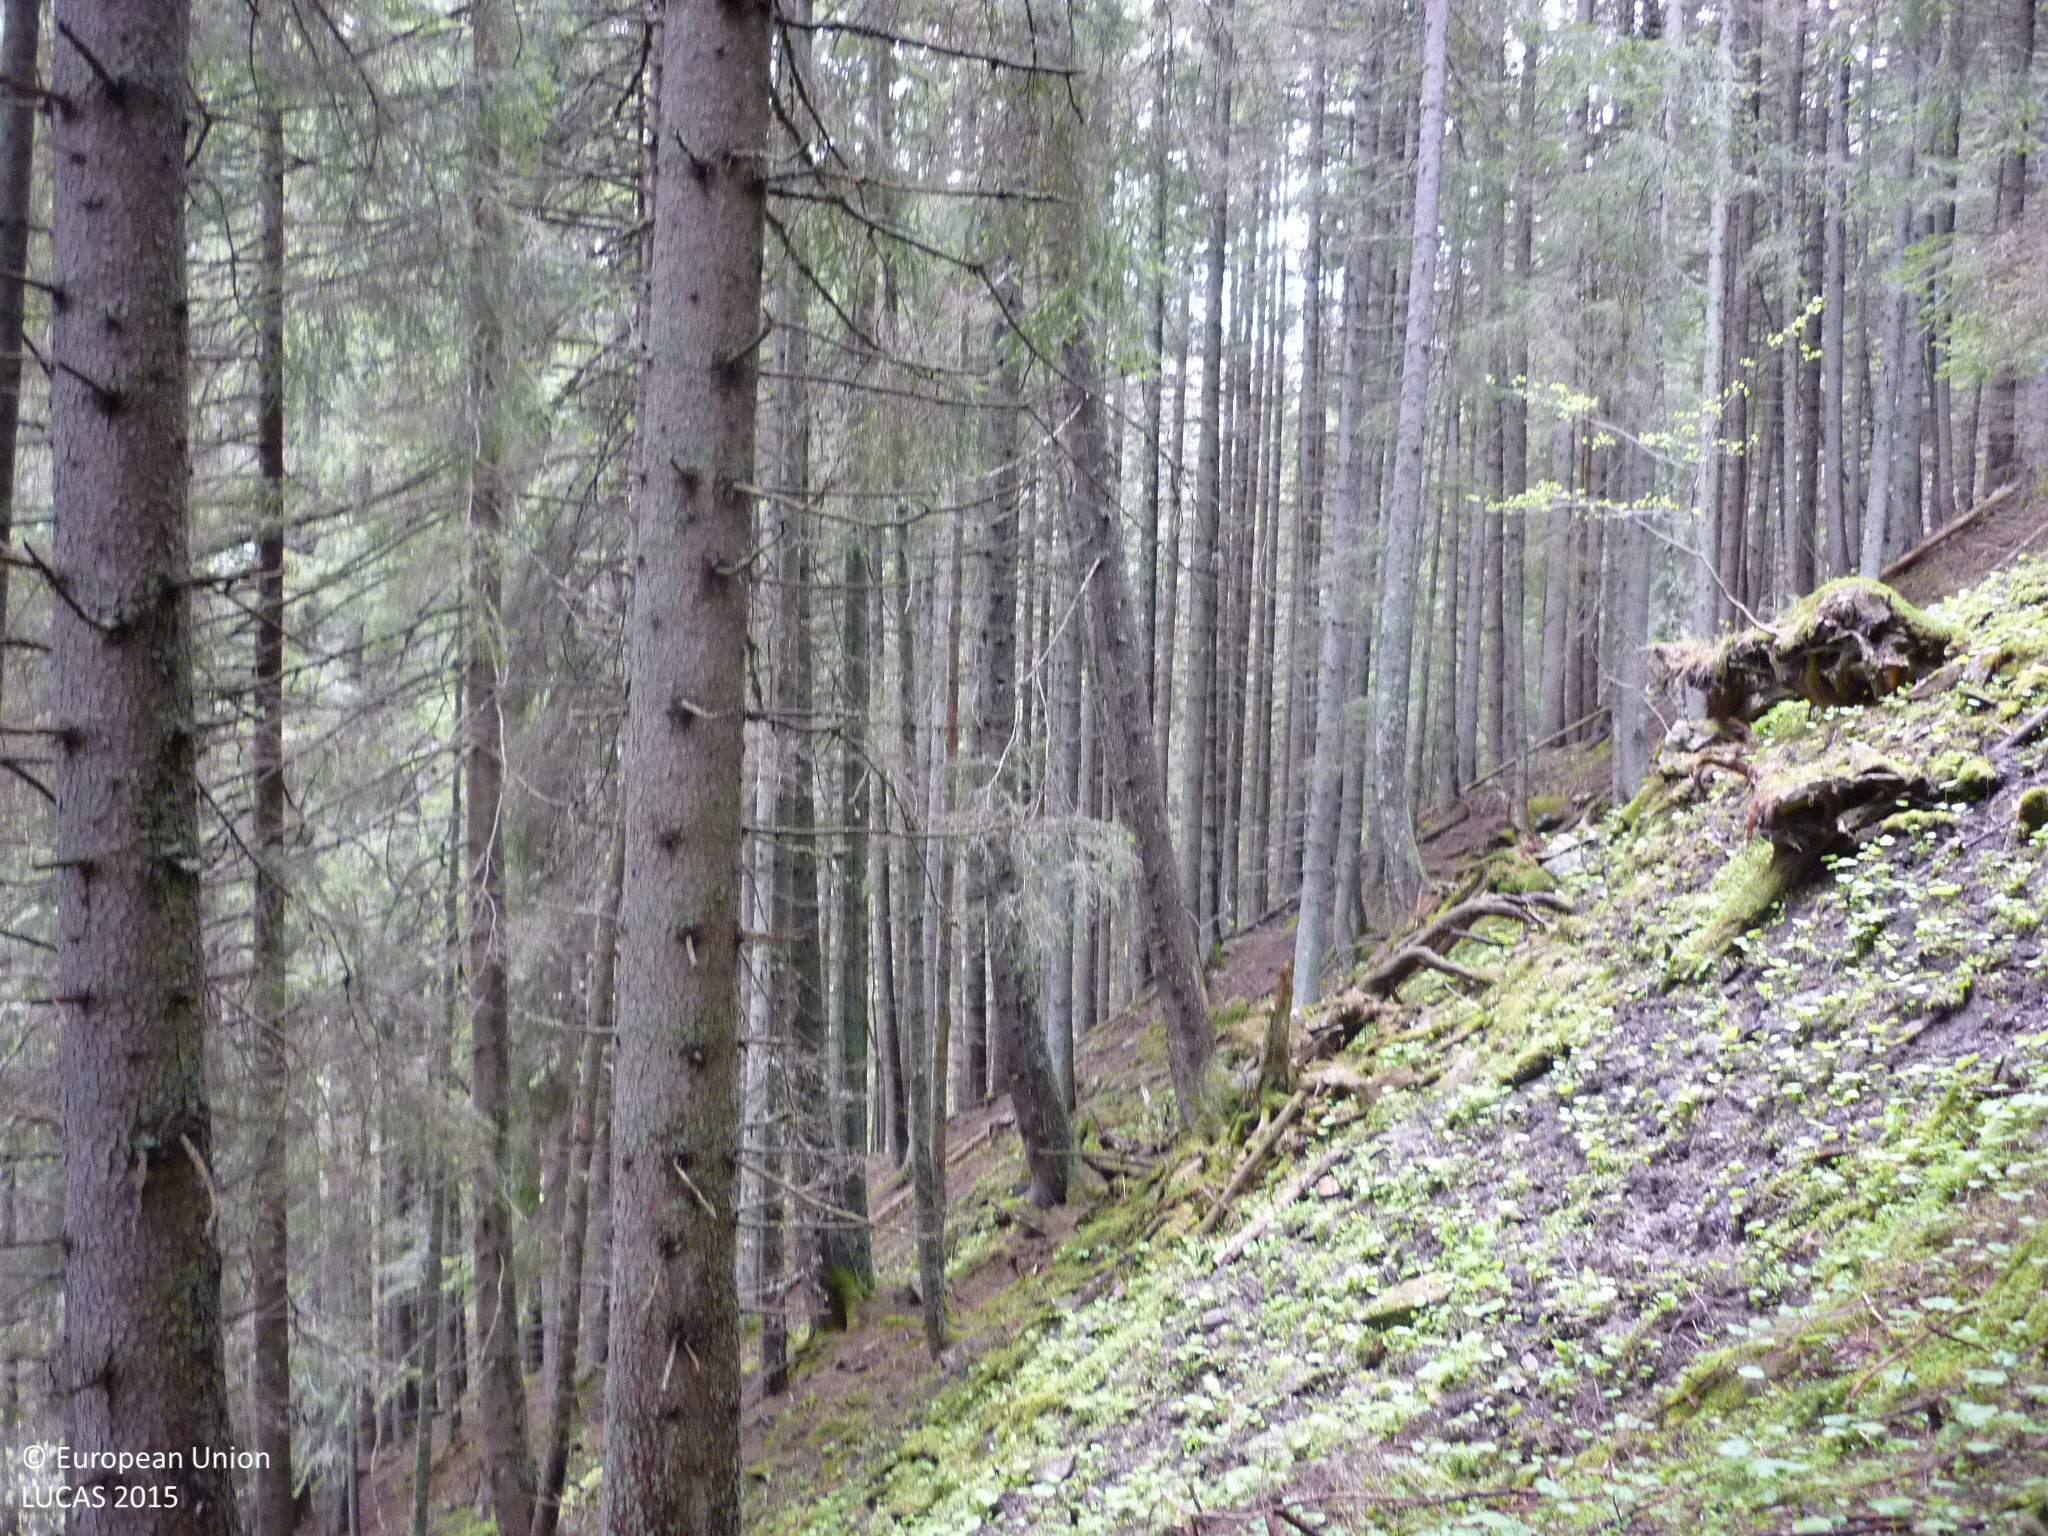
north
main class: Woodland
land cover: Spruce dominated coniferous woodland
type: alpine coniferous forest
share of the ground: > 75 %
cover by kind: coniferous forest trees 85 %, herbaceous plants 5 %, lichens and mosses 5 %, unconsolidated bare surface 5 %
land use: Forestry
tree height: > 5 m
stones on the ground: 10 - 25 %
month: May
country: AT
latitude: 47.3029
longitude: 14.0323
